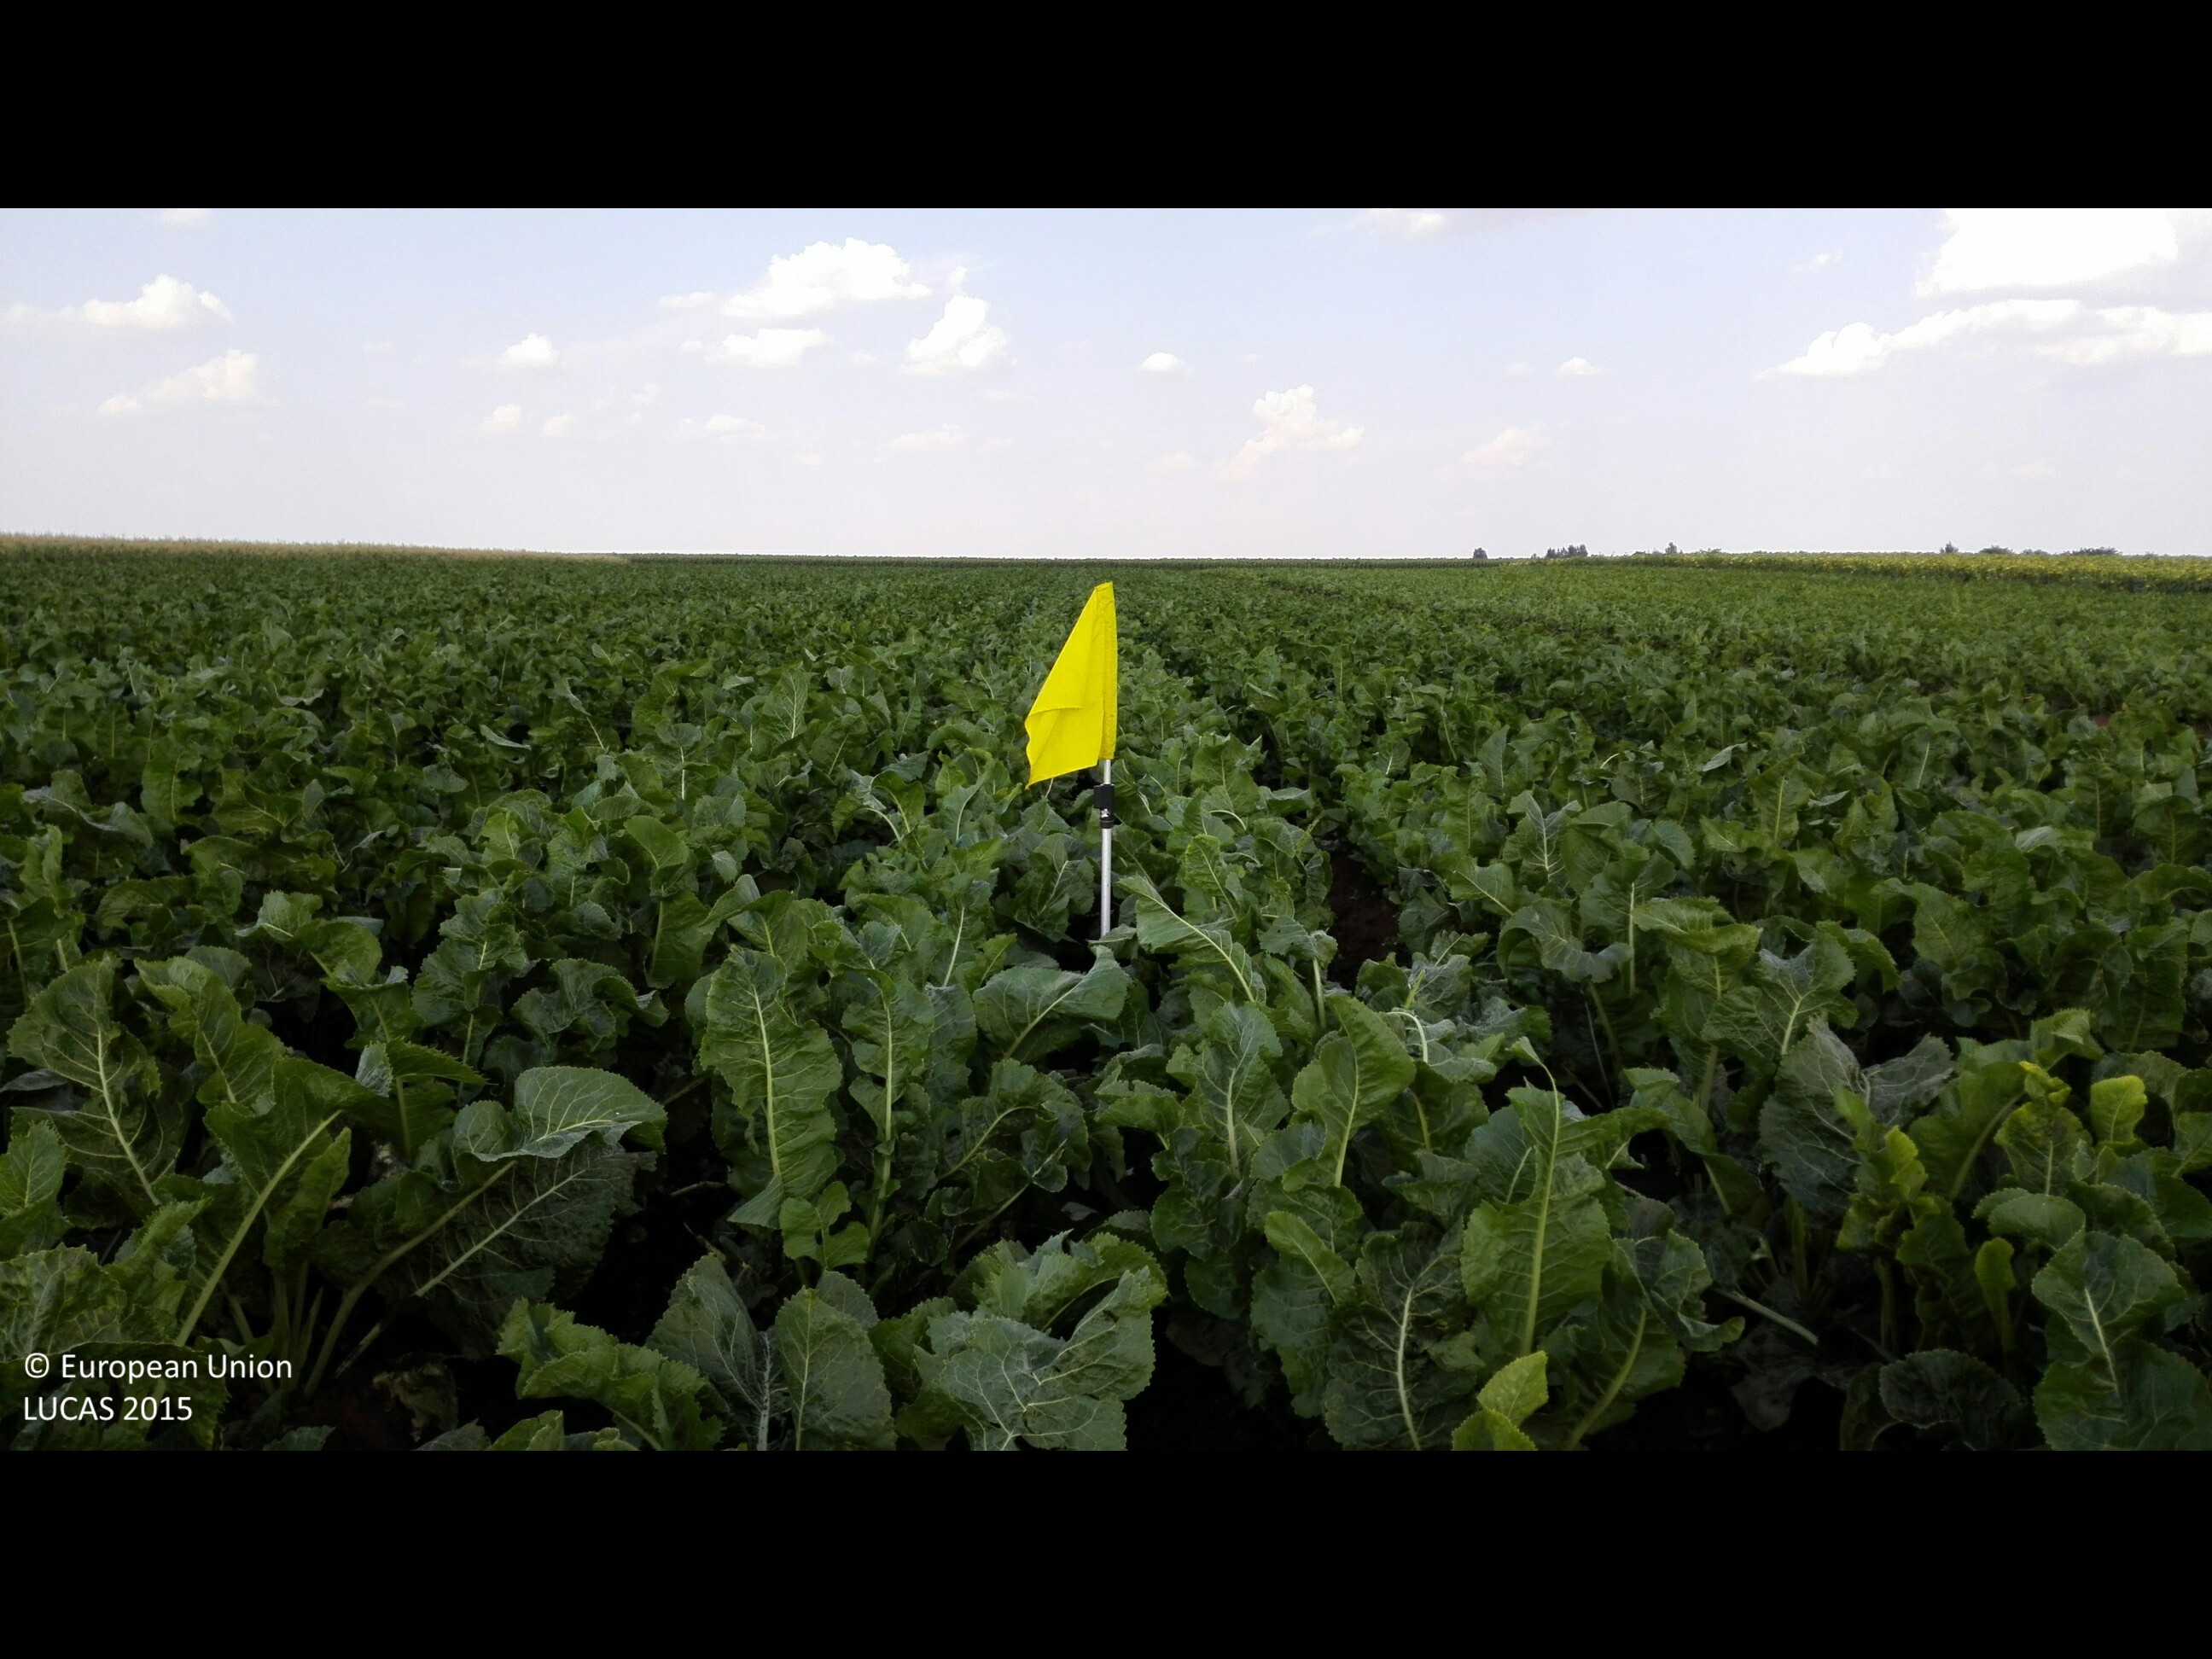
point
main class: Cropland
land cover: Other root crops
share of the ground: > 75 %
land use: Agriculture (excluding fallow land and kitchen gardens)
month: August
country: HU
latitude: 47.4029
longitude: 21.9880
